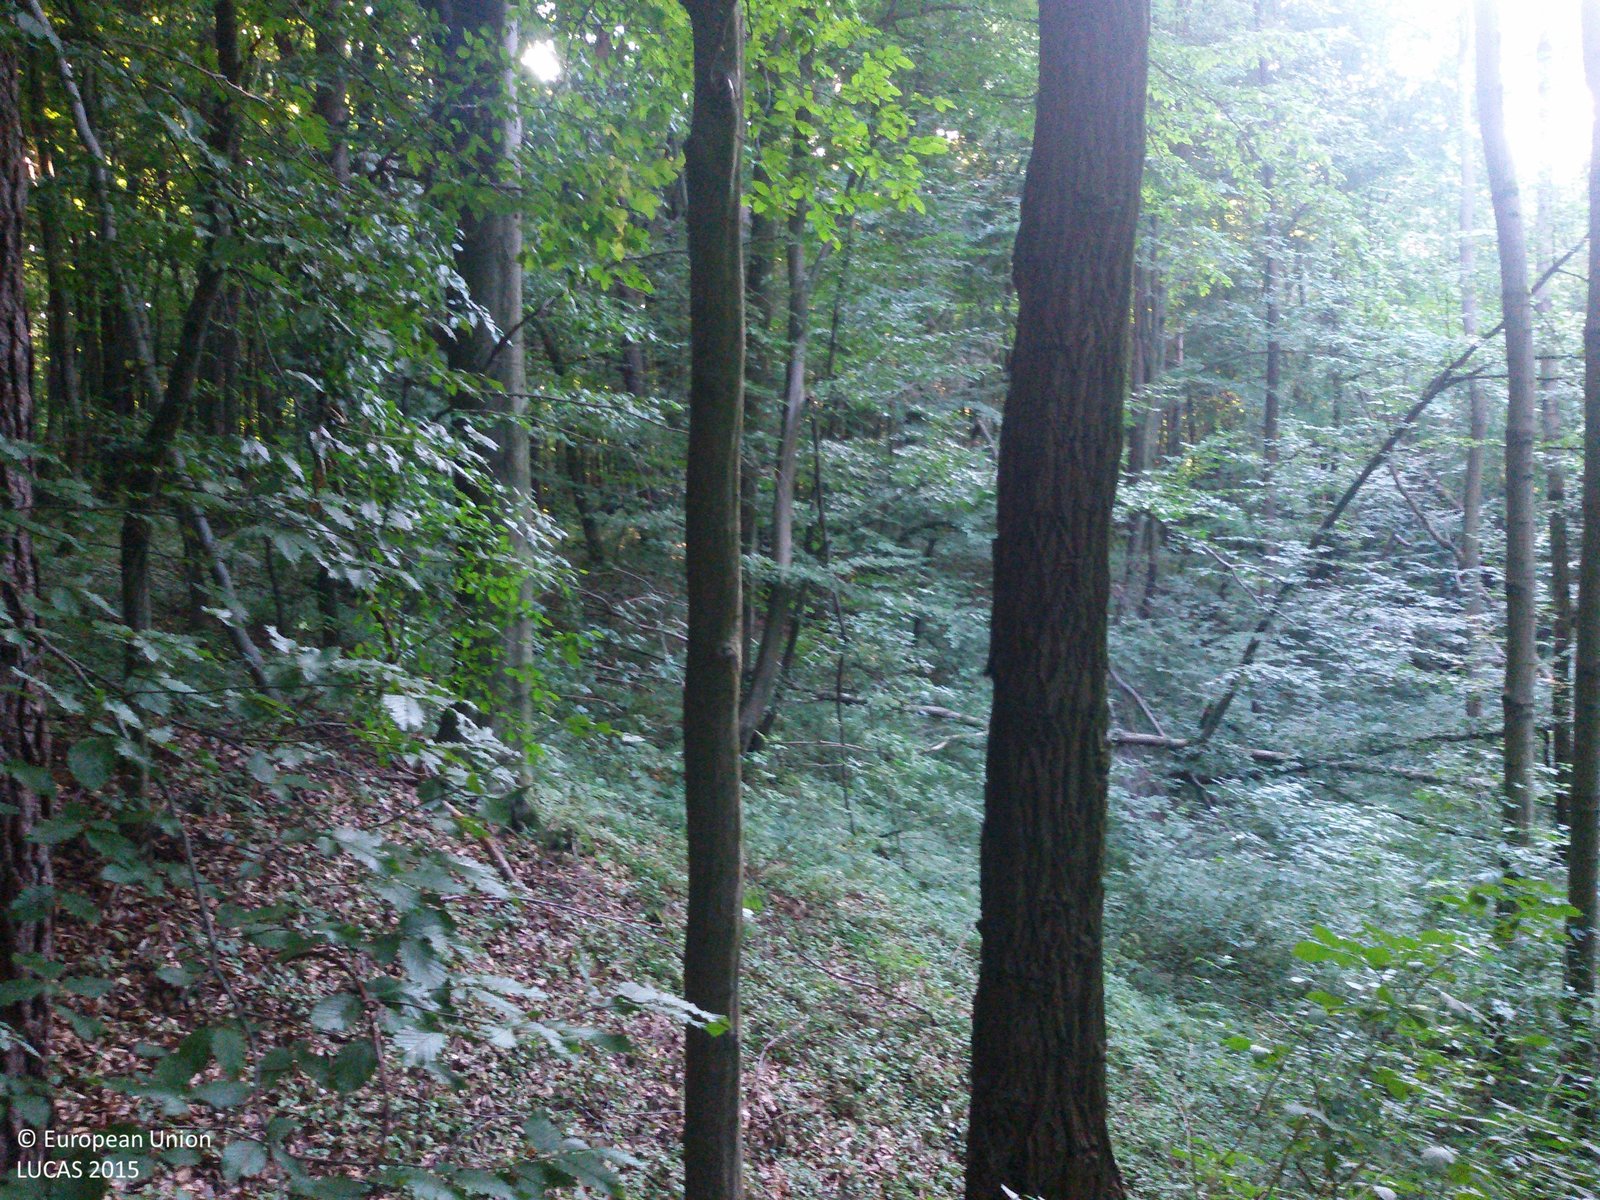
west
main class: Woodland
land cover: Broadleaved woodland
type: mesophytic deciduous forest
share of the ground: > 75 %
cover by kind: broadleaved forest trees 80 %, shrubs 10 %, herbaceous plants 10 %
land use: Forestry
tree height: > 5 m
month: July
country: PL
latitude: 50.9190
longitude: 23.4111
